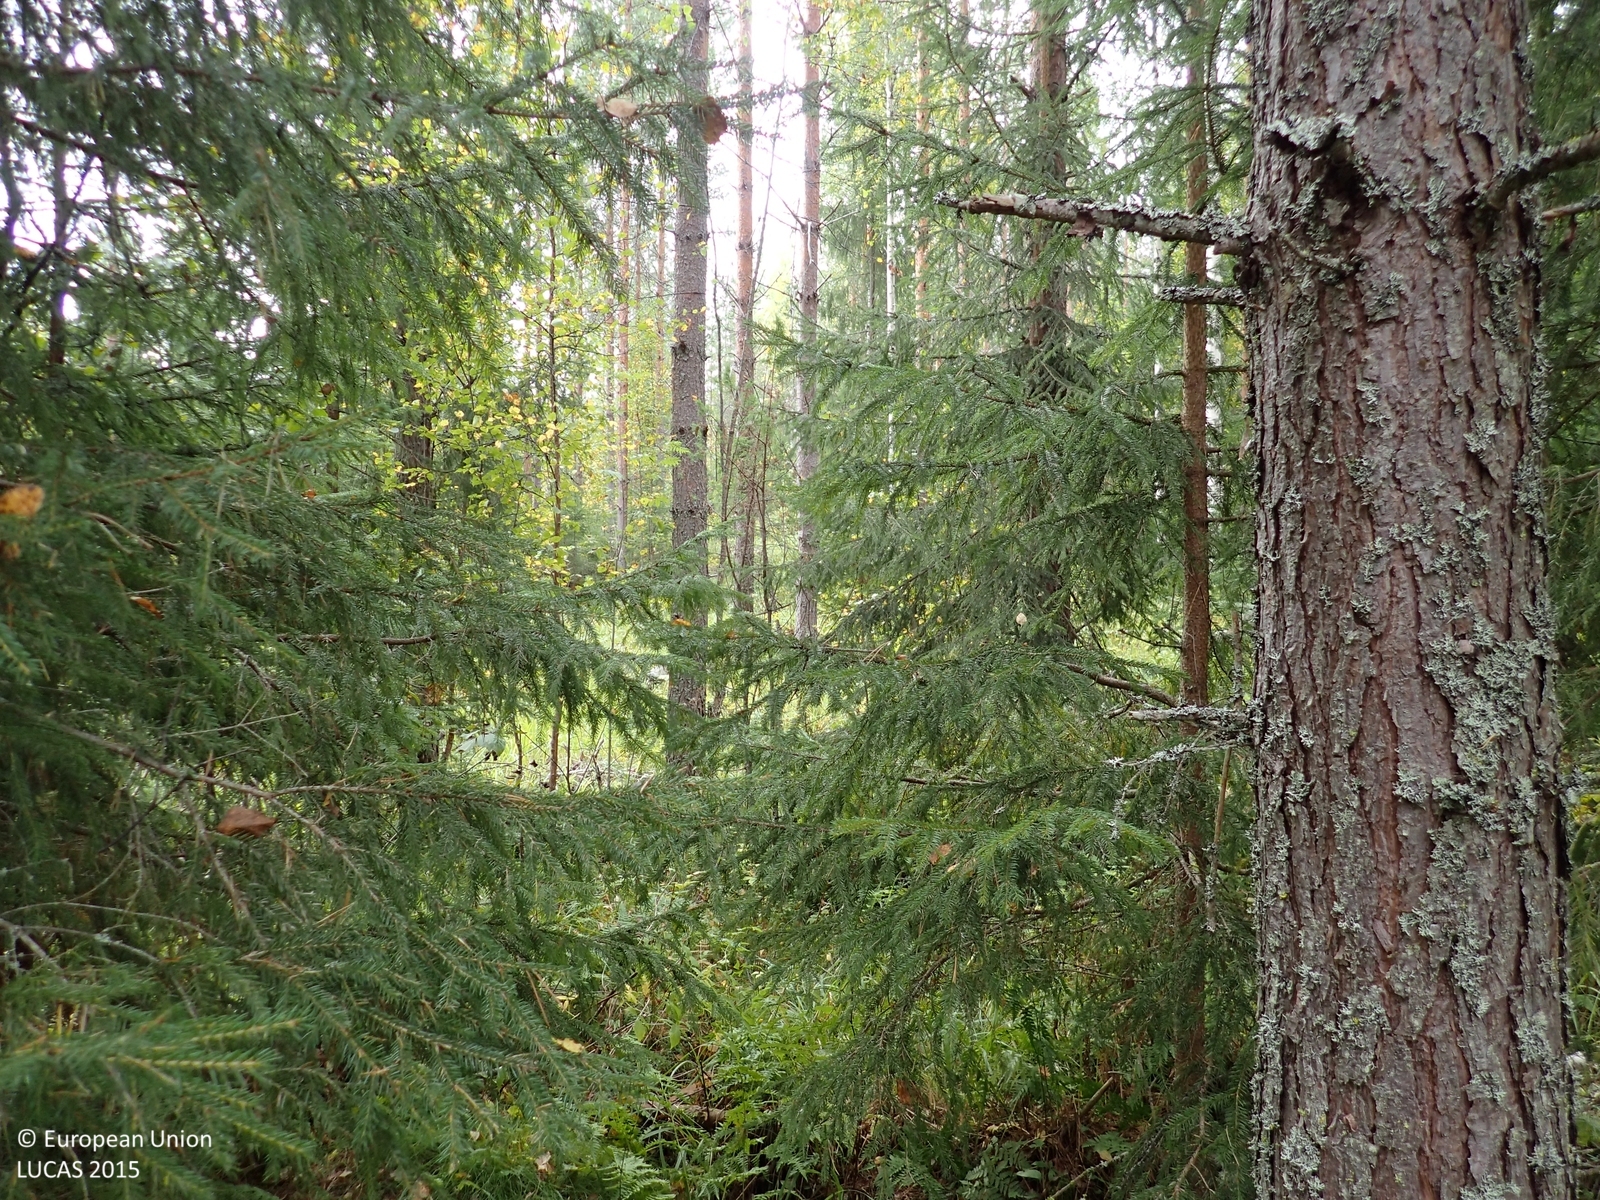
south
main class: Woodland
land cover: Pine dominated mixed woodland
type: boreal forest
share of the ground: > 75 %
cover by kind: coniferous forest trees 55 %, broadleaved forest trees 20 %, herbaceous plants 15 %, shrubs 5 %, lichens and mosses 5 %
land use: Forestry
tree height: > 5 m
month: September
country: FI
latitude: 62.9414
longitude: 25.9002
